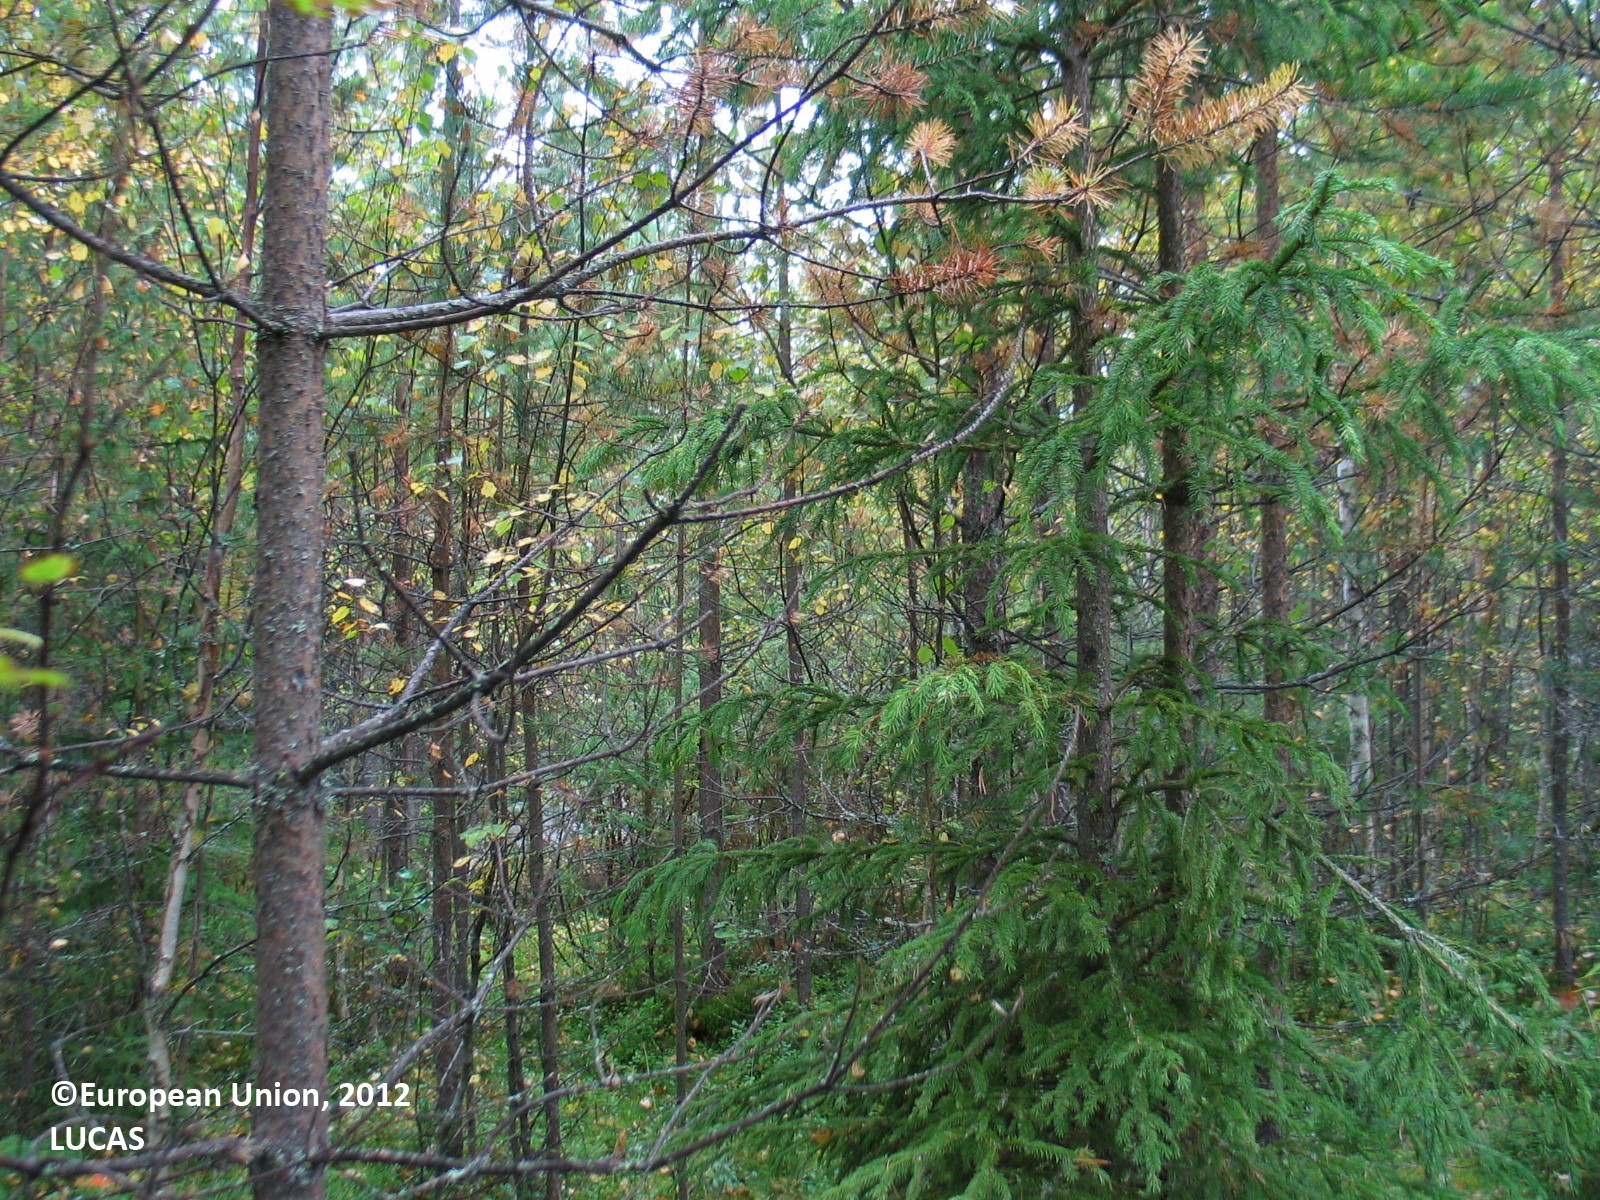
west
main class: Woodland
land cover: Pine dominated mixed woodland
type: boreal forest
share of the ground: 50 - 75 %
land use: Forestry
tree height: > 5 m
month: September
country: FI
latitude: 65.2166
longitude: 25.5396
